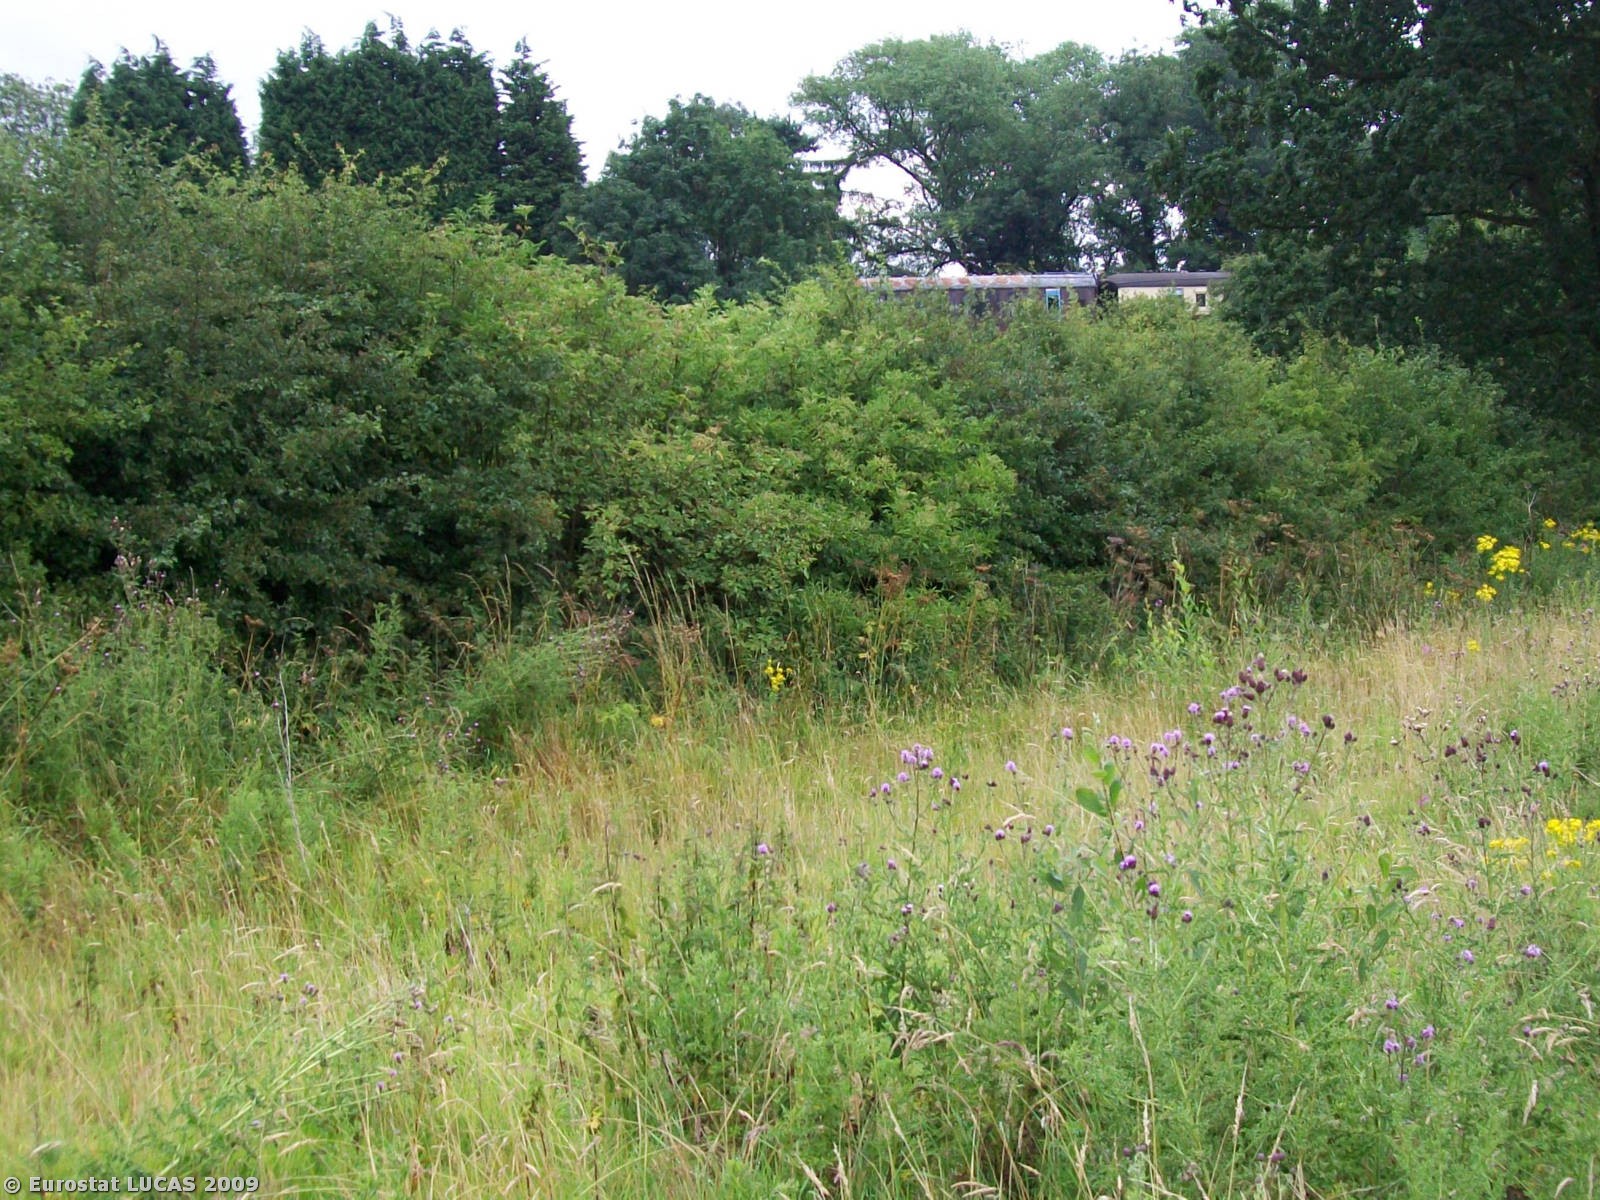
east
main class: Grassland
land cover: Grassland without tree/shrub cover
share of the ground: > 75 %
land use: Agriculture (excluding fallow land and kitchen gardens)
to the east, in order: Grassland without tree/shrub cover; Abandoned hedges; Grassland without tree/shrub cover; Fences; Railways; Broadleaved woodland; Grassland with sparse tree/shrub cover; Broadleaved woodland; Tracks; Grassland without tree/shrub cover
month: July
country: GB
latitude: 52.7027
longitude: -1.1602
